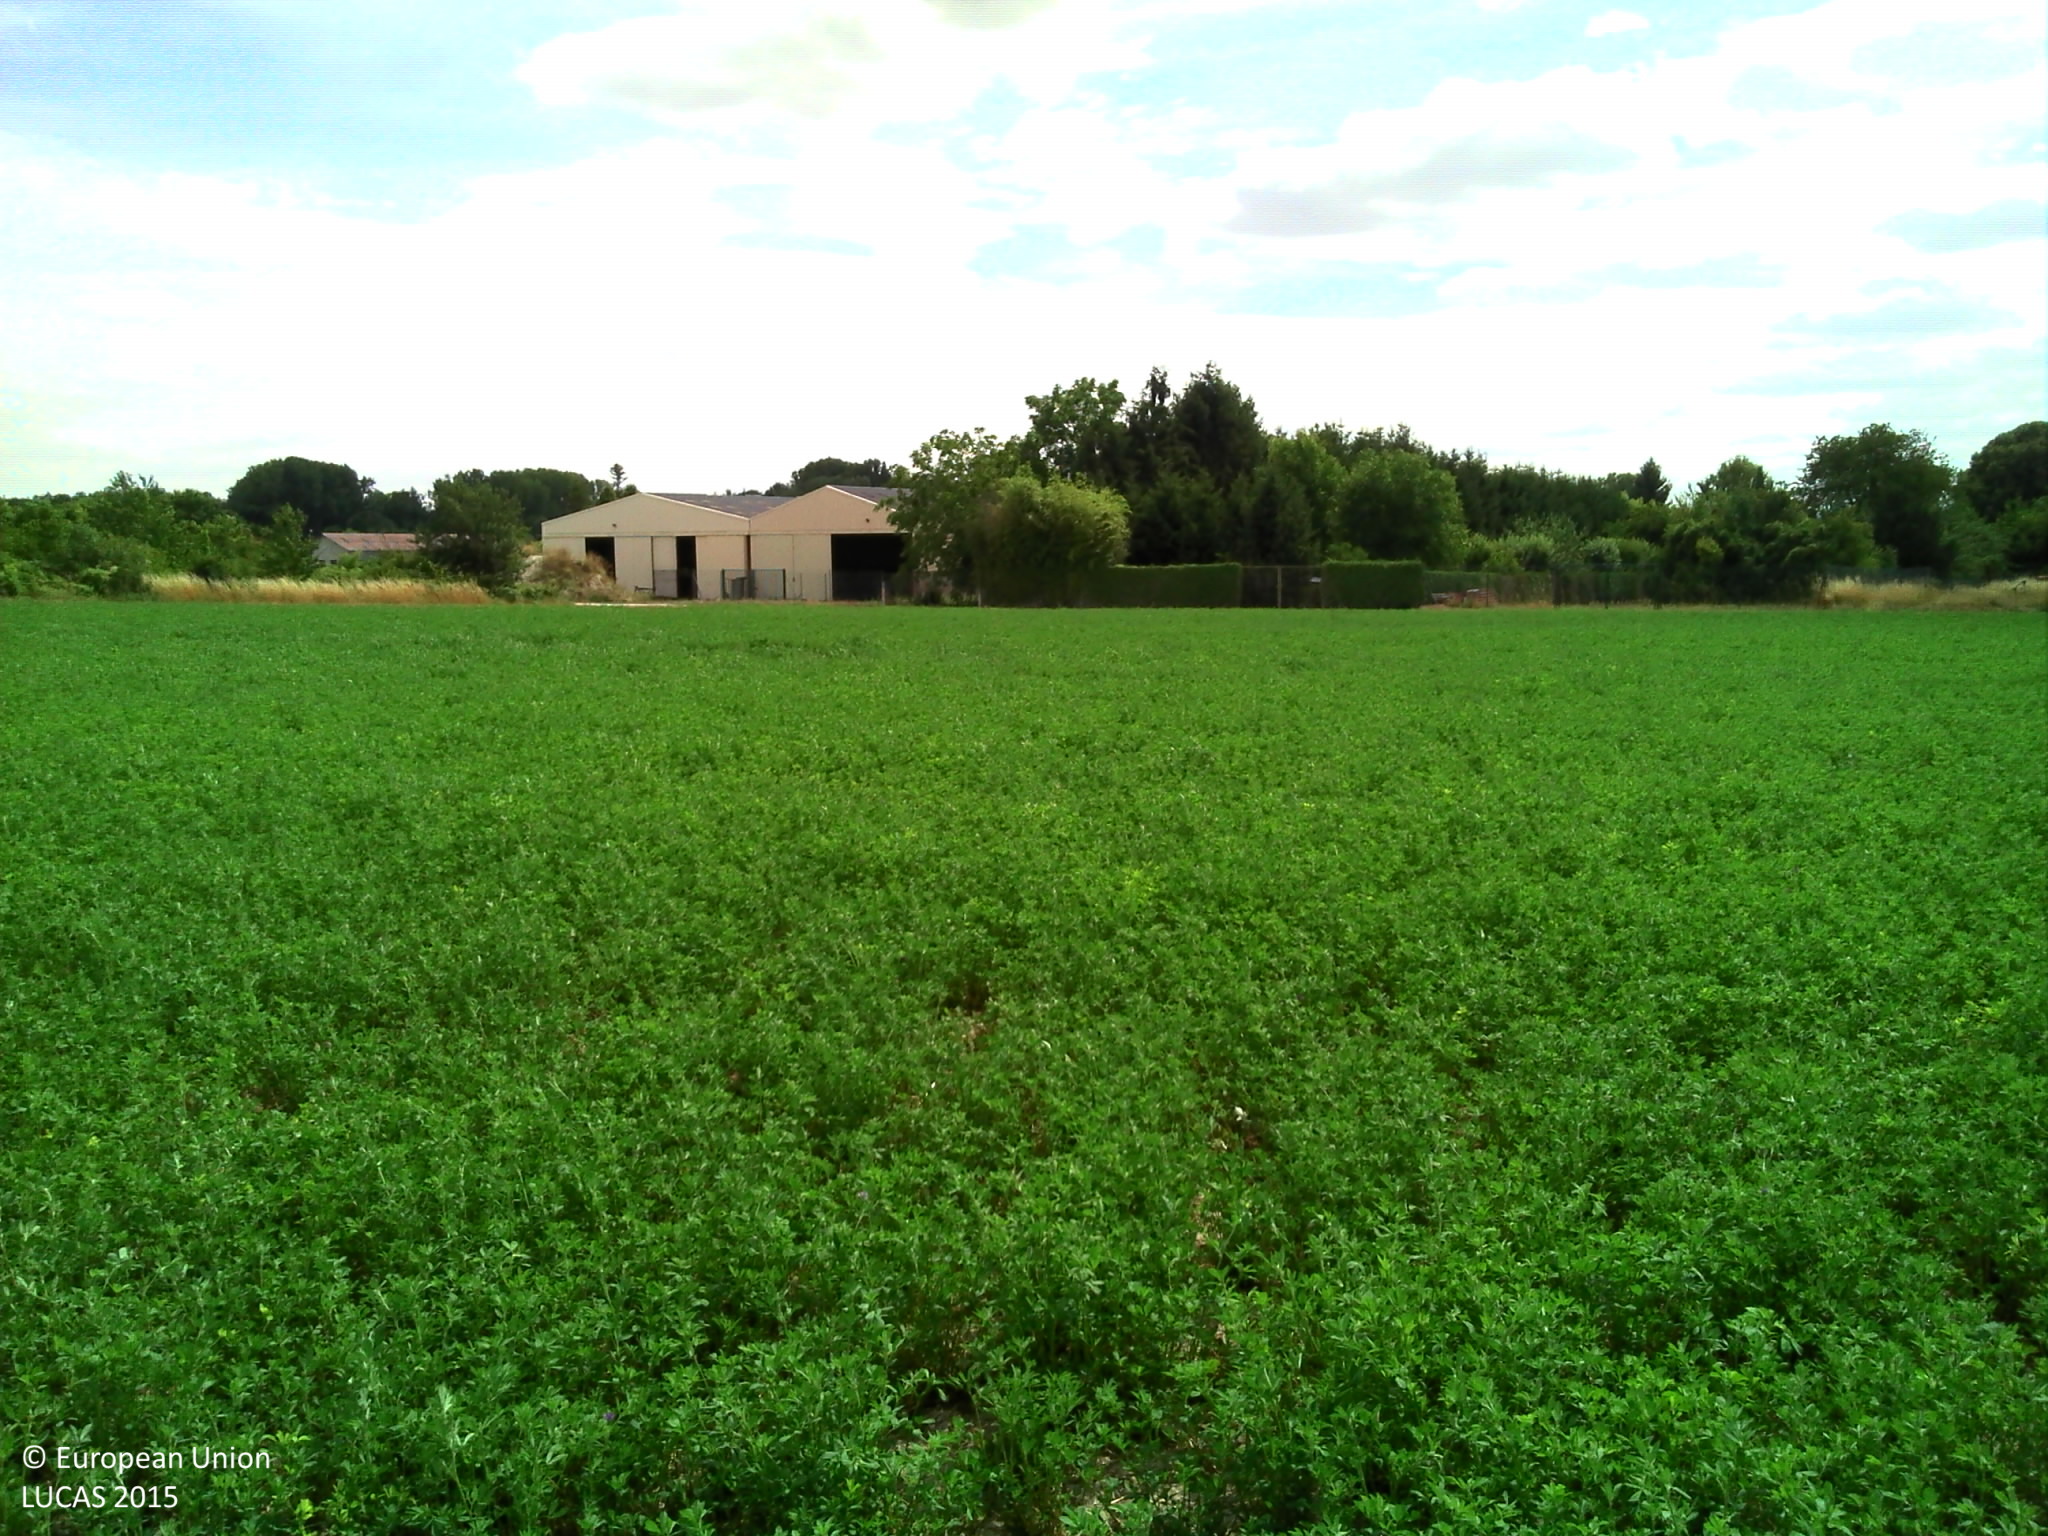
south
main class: Cropland
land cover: Lucerne
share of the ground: > 75 %
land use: Agriculture (excluding fallow land and kitchen gardens)
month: July
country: FR
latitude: 49.3529
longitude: 4.2273
